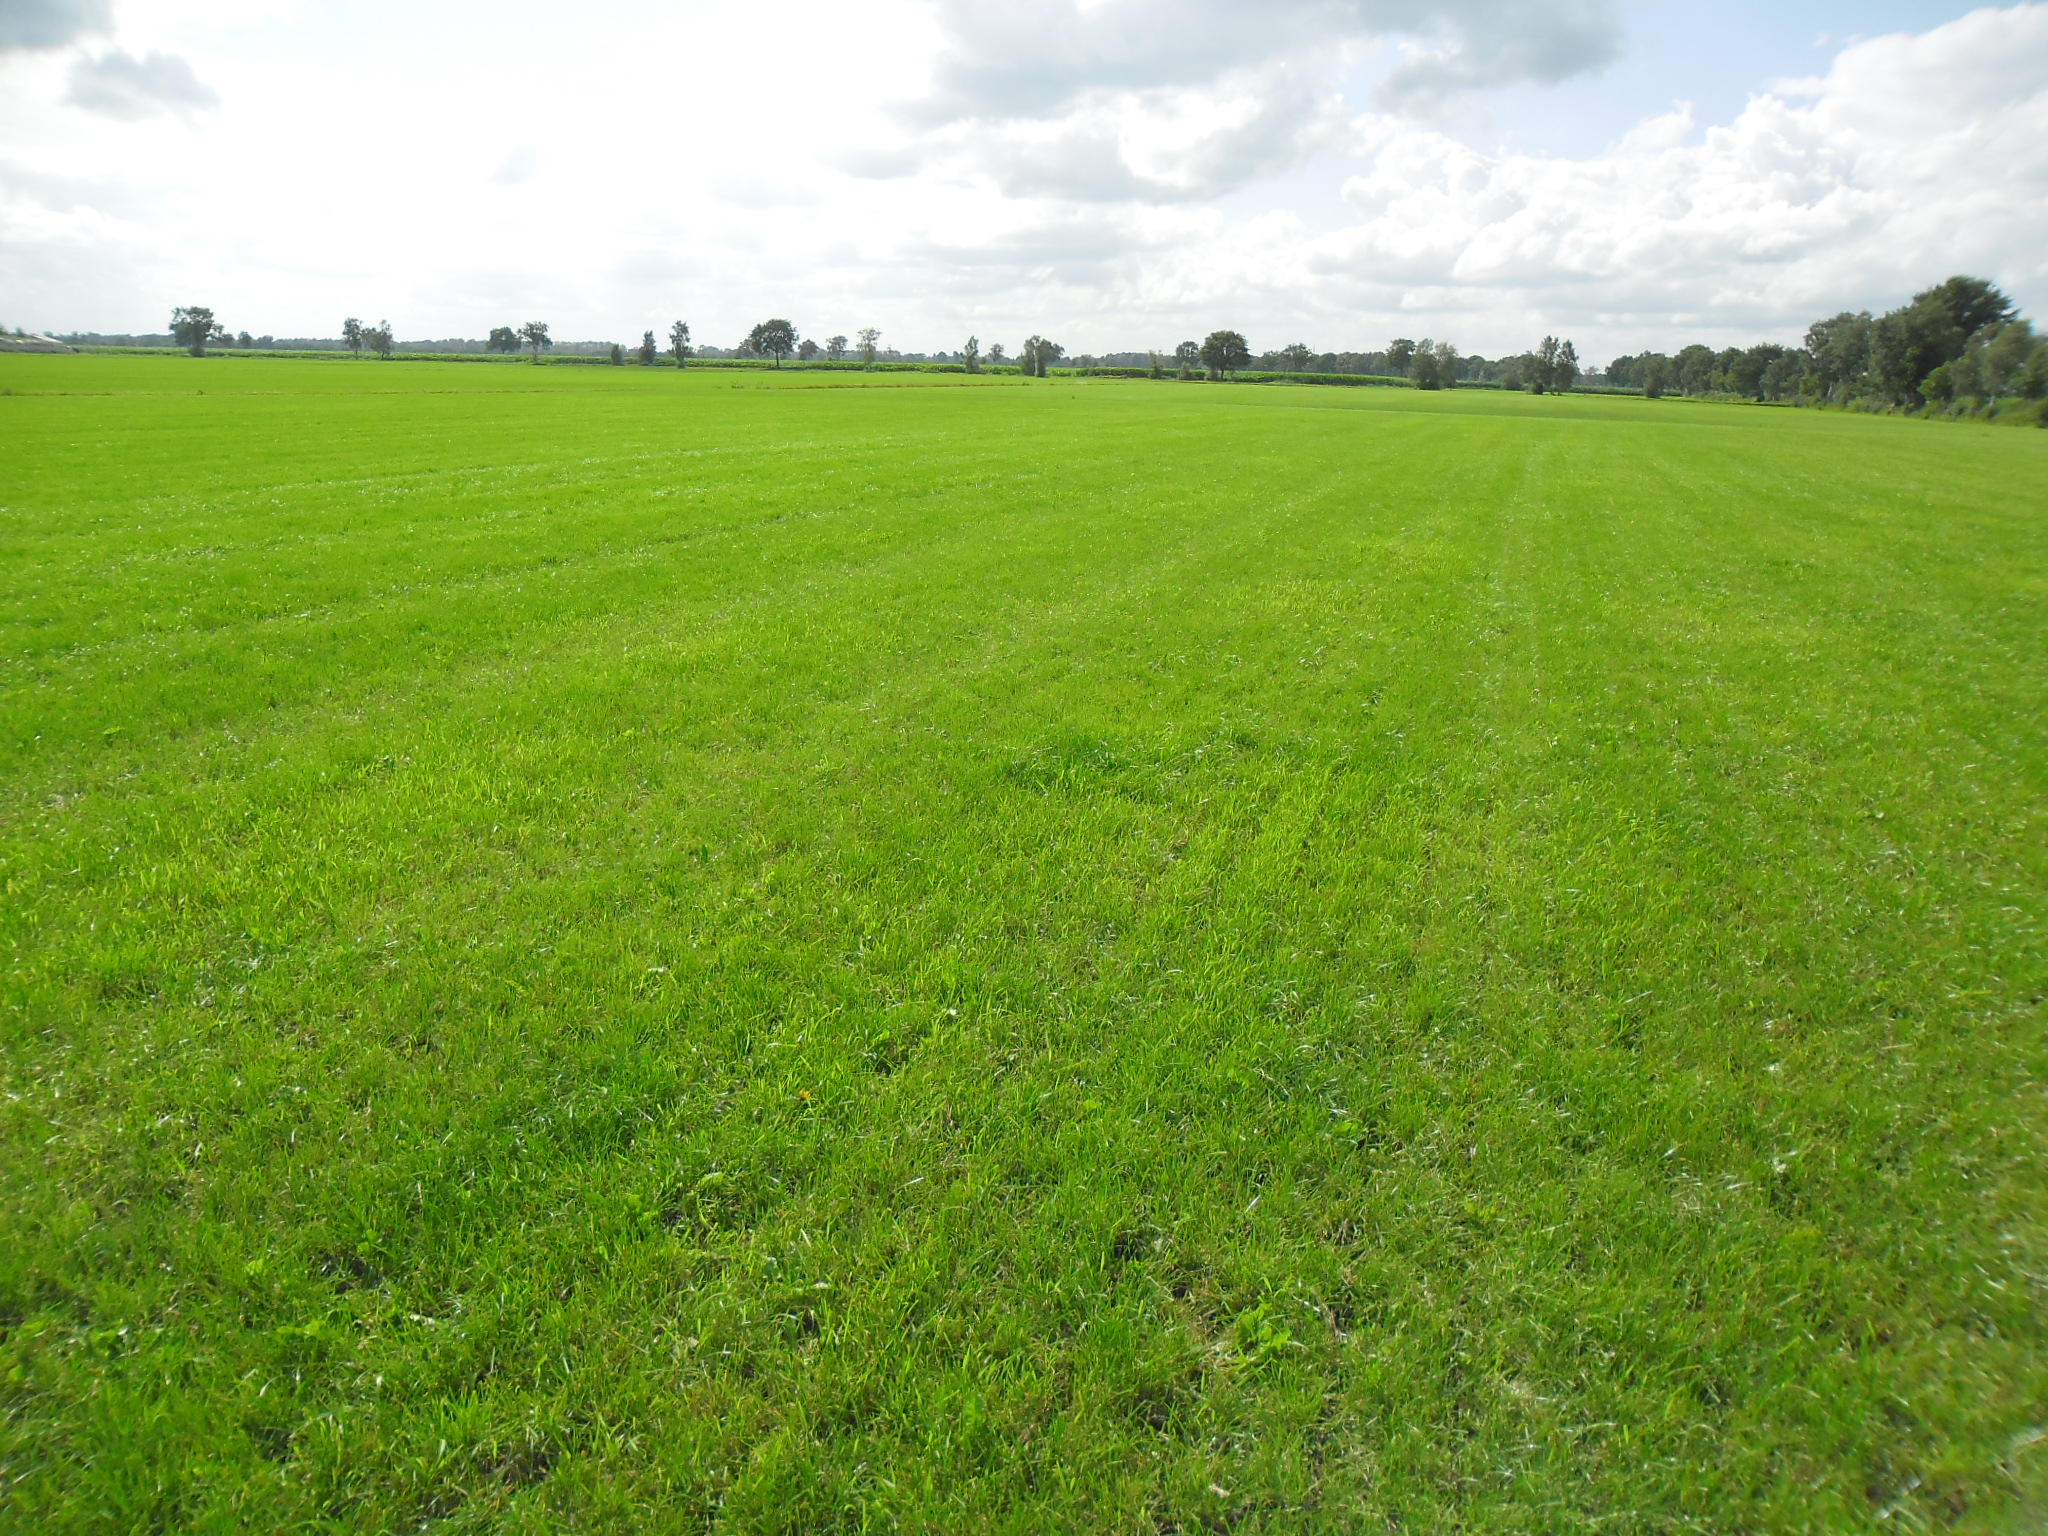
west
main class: Grassland
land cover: Grassland without tree/shrub cover
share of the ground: > 75 %
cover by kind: herbaceous plants 100 %
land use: Agriculture (excluding fallow land and kitchen gardens)
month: July
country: NL
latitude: 52.6057
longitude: 6.2342
